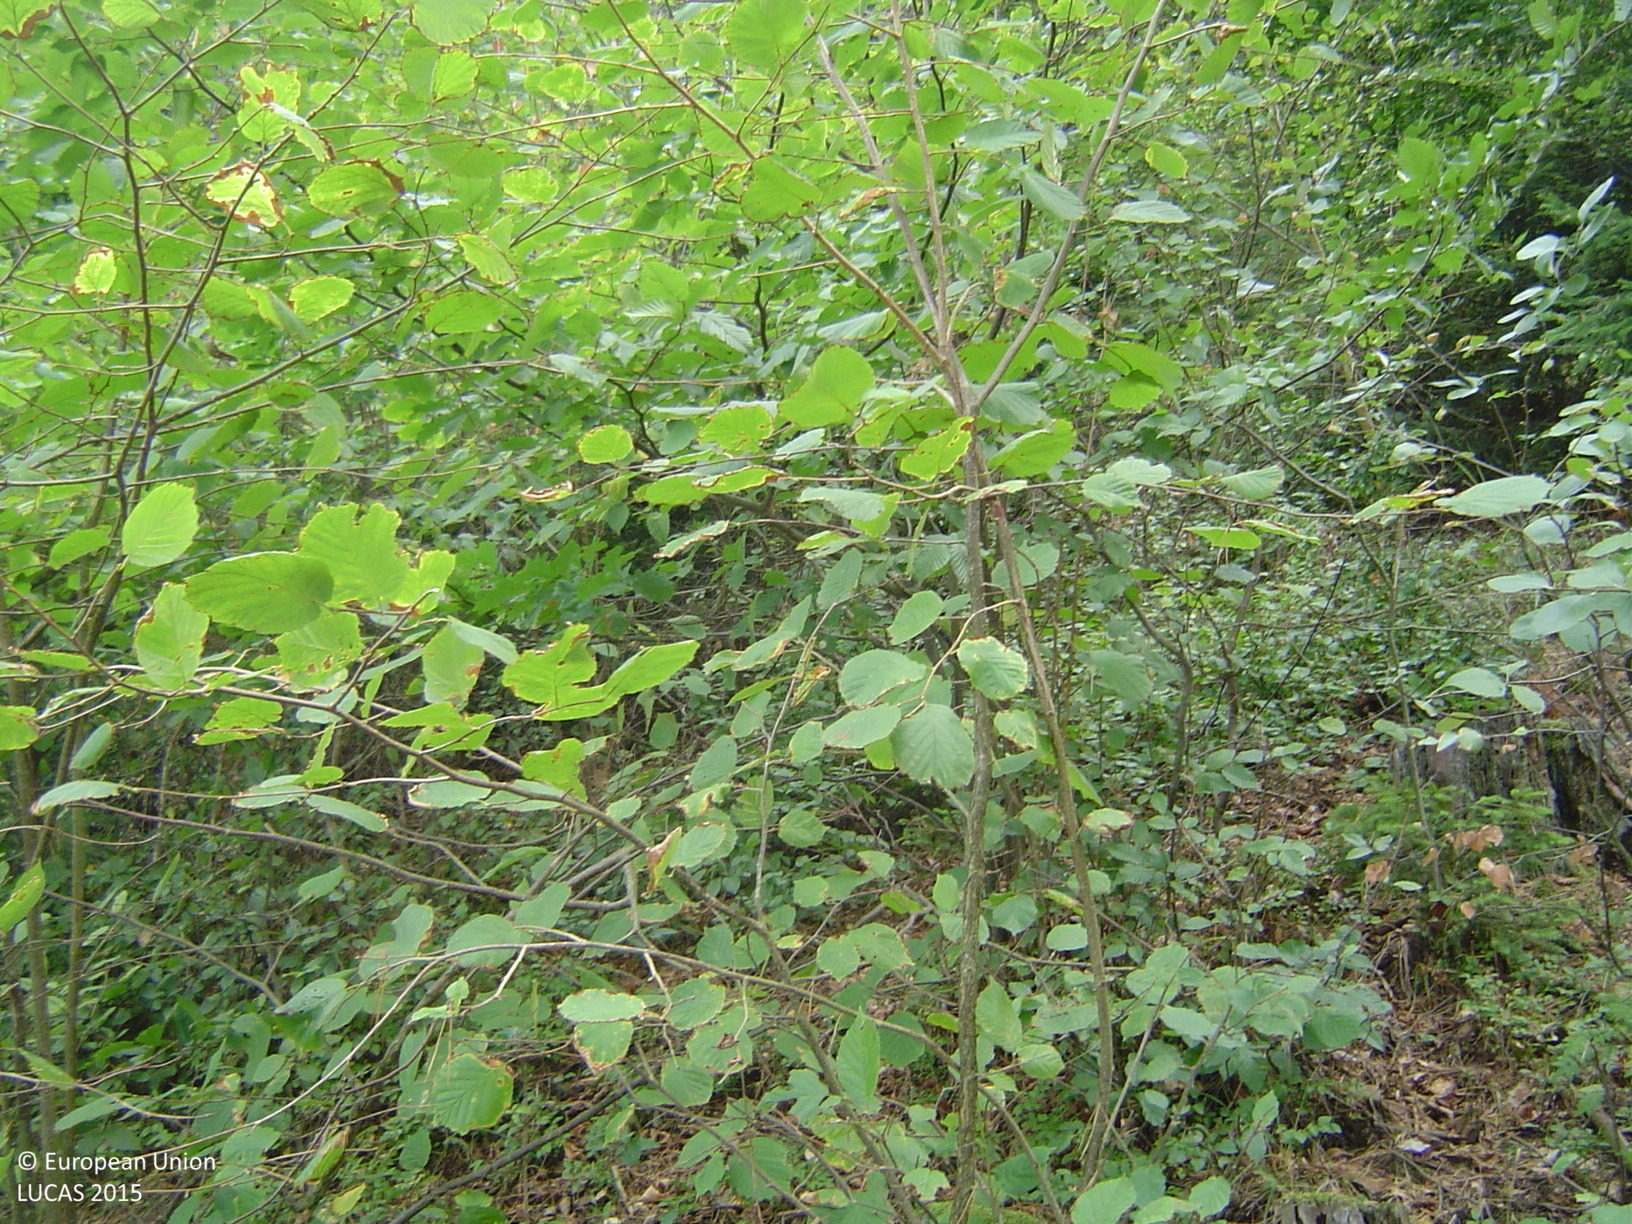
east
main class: Woodland
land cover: Pine dominated mixed woodland
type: hemiboreal forest and nemoral coniferous forest and mixed broadleaved-coniferous forest
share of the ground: > 75 %
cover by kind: coniferous forest trees 65 %, broadleaved forest trees 25 %, shrubs 10 %
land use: Forestry
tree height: > 5 m
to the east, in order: Pine dominated mixed woodland; Tracks; Other mixed woodland; Broadleaved woodland
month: August
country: CZ
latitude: 49.7930
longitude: 14.4050
